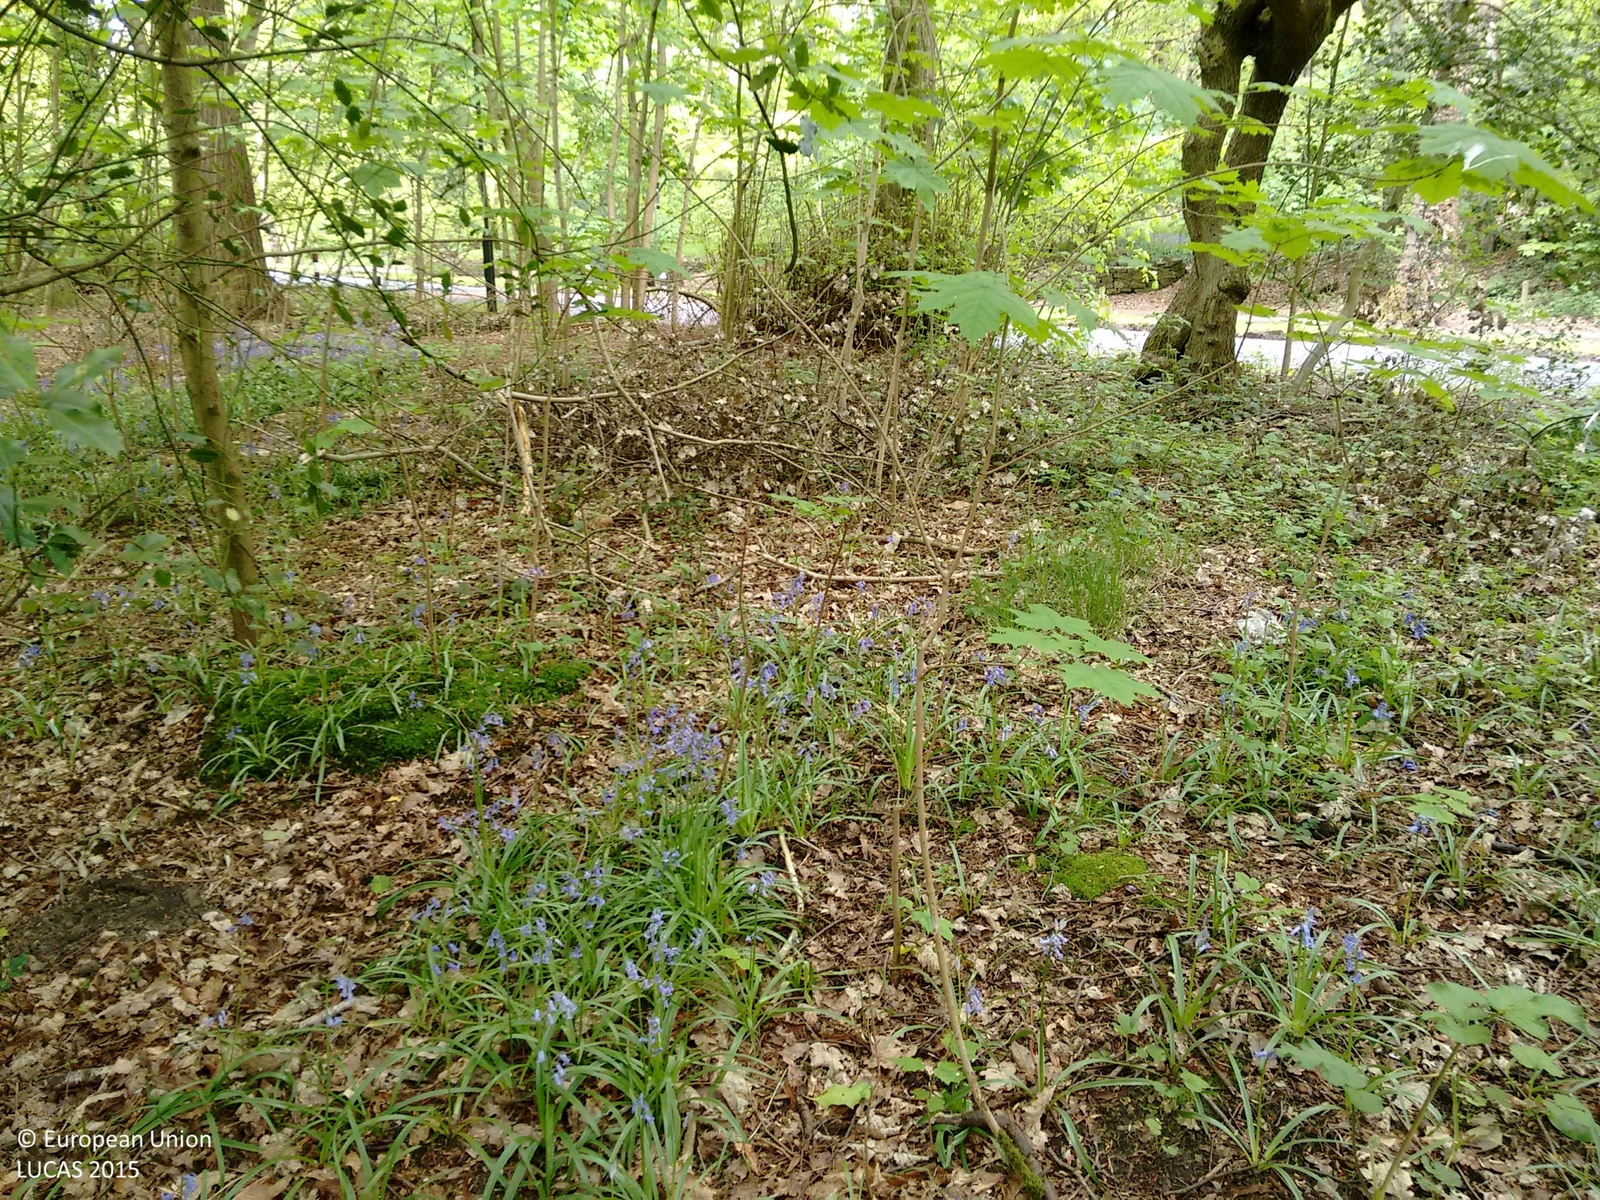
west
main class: Woodland
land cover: Broadleaved woodland
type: mesophytic deciduous forest
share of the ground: > 75 %
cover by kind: broadleaved forest trees 100 %
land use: Semi-natural and natural areas not in use
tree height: > 5 m
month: May
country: GB
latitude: 53.3415
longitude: -1.5103
